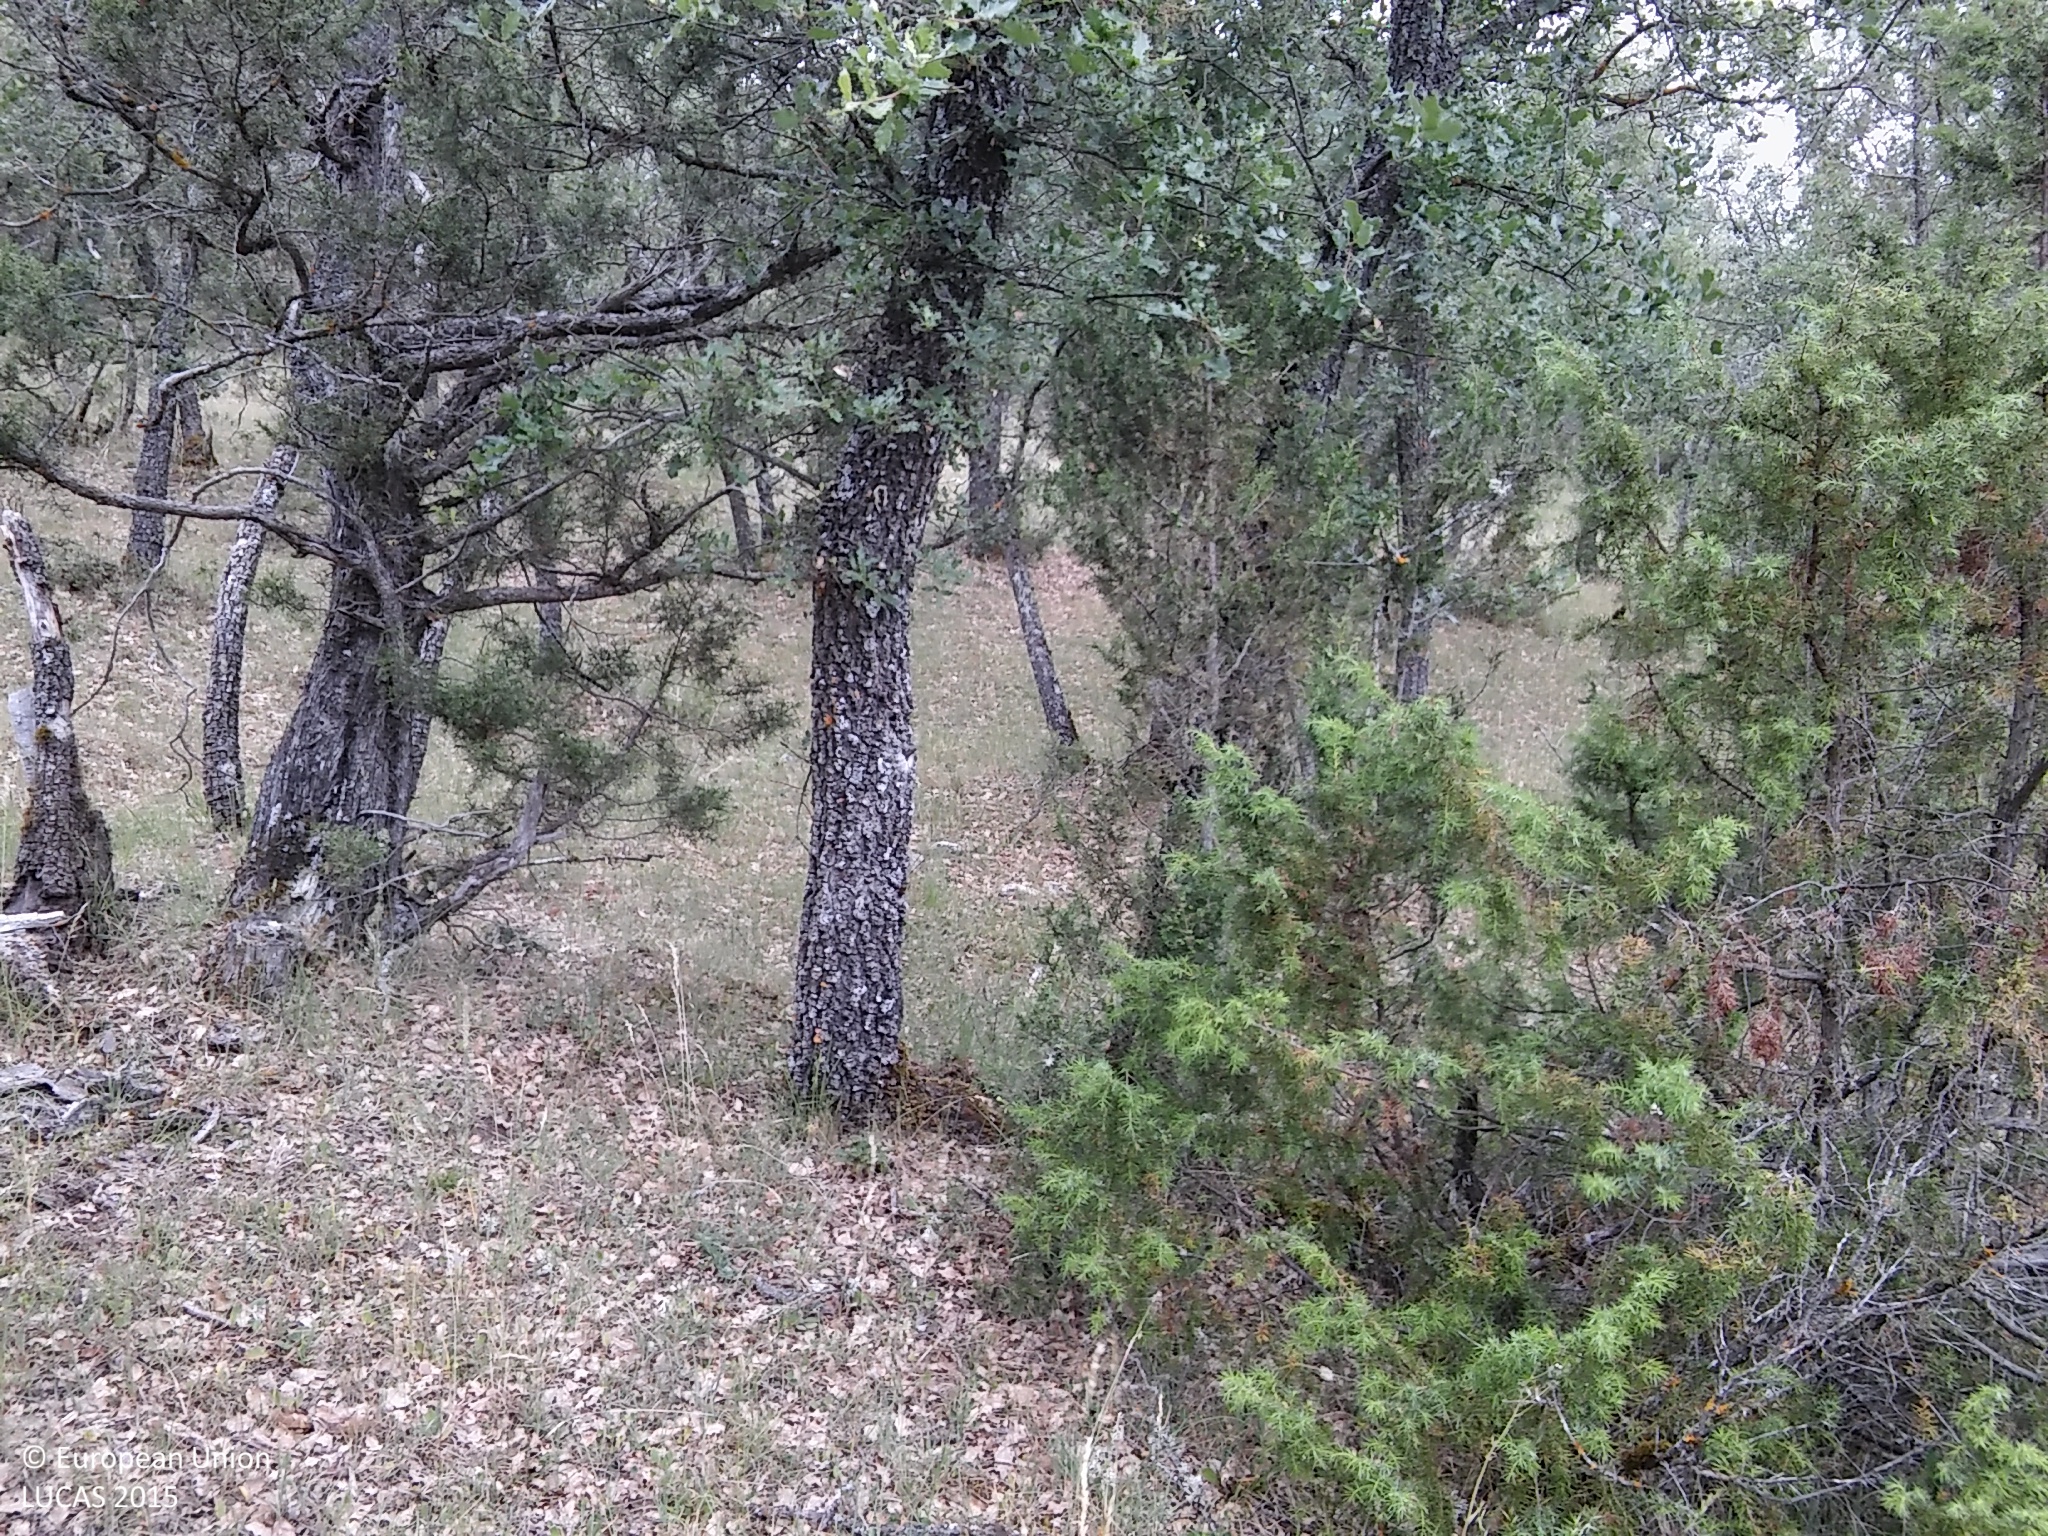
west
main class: Woodland
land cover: Broadleaved woodland
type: acidophilous oak and oak-birch forest
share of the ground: 50 - 75 %
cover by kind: broadleaved forest trees 70 %, herbaceous plants 15 %, unconsolidated bare surface 10 %, shrubs 5 %
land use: Agriculture (excluding fallow land and kitchen gardens)
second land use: Forestry
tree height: > 5 m
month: June
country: ES
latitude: 41.2153
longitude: -3.6318
